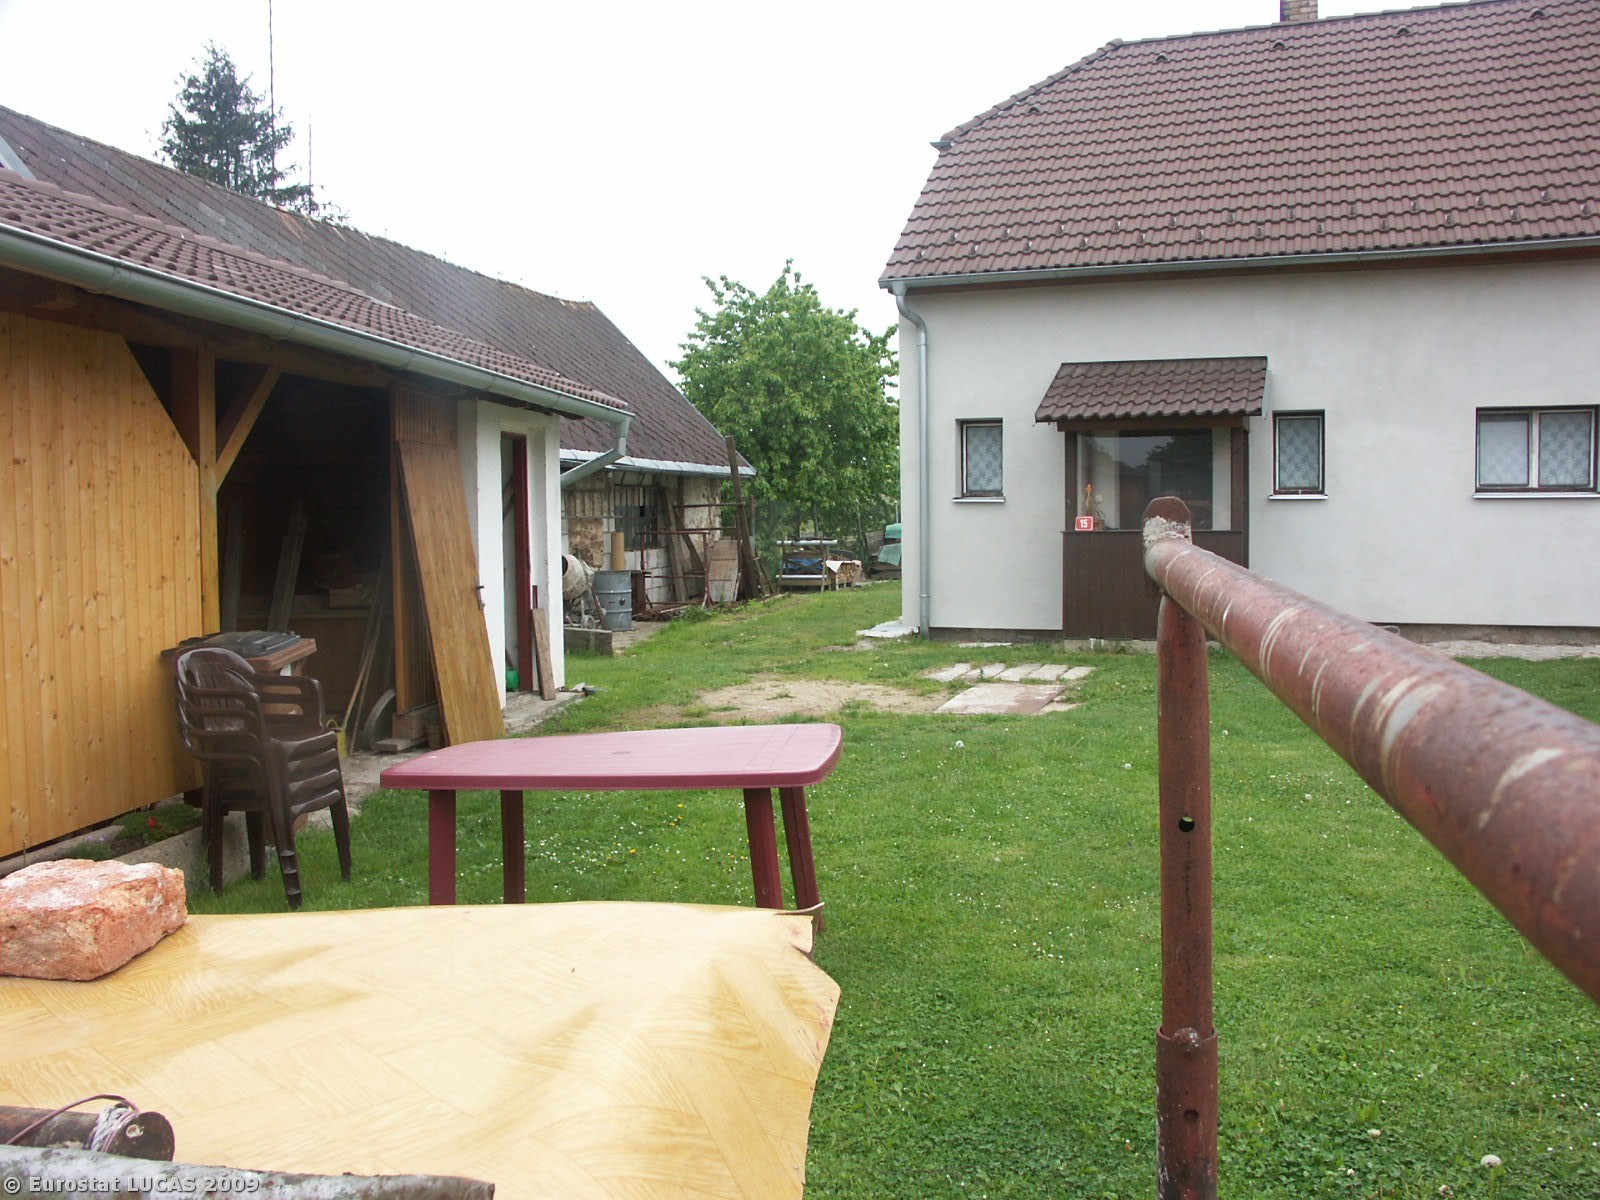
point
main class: Cropland
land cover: Cherry fruit
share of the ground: 50 - 75 %
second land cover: Grassland with sparse tree/shrub cover
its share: > 75 %
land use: Kitchen garden
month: May
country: CZ
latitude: 49.1577
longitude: 14.9523
